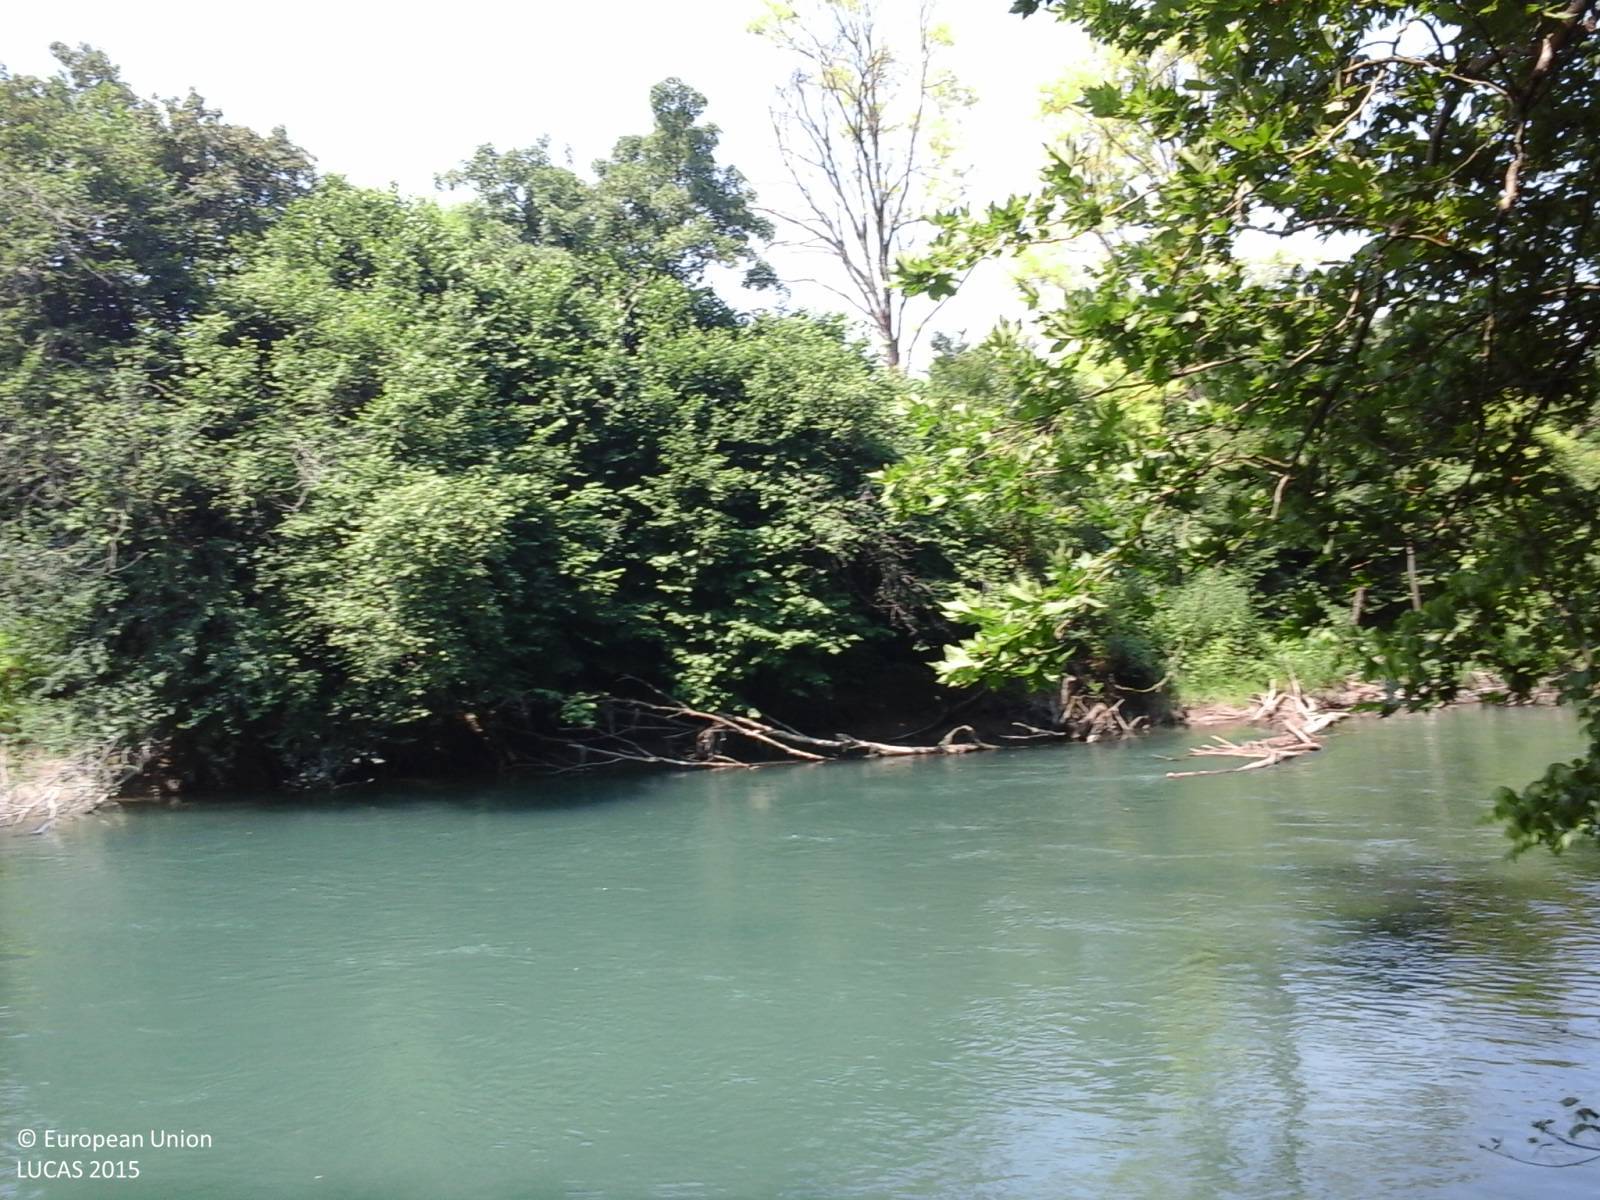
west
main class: Woodland
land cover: Broadleaved woodland
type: floodplain forest
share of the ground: > 75 %
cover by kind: broadleaved forest trees 70 %, shrubs 30 %
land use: Semi-natural and natural areas not in use
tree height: > 5 m
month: June
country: IT
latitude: 45.9252
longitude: 12.5112
